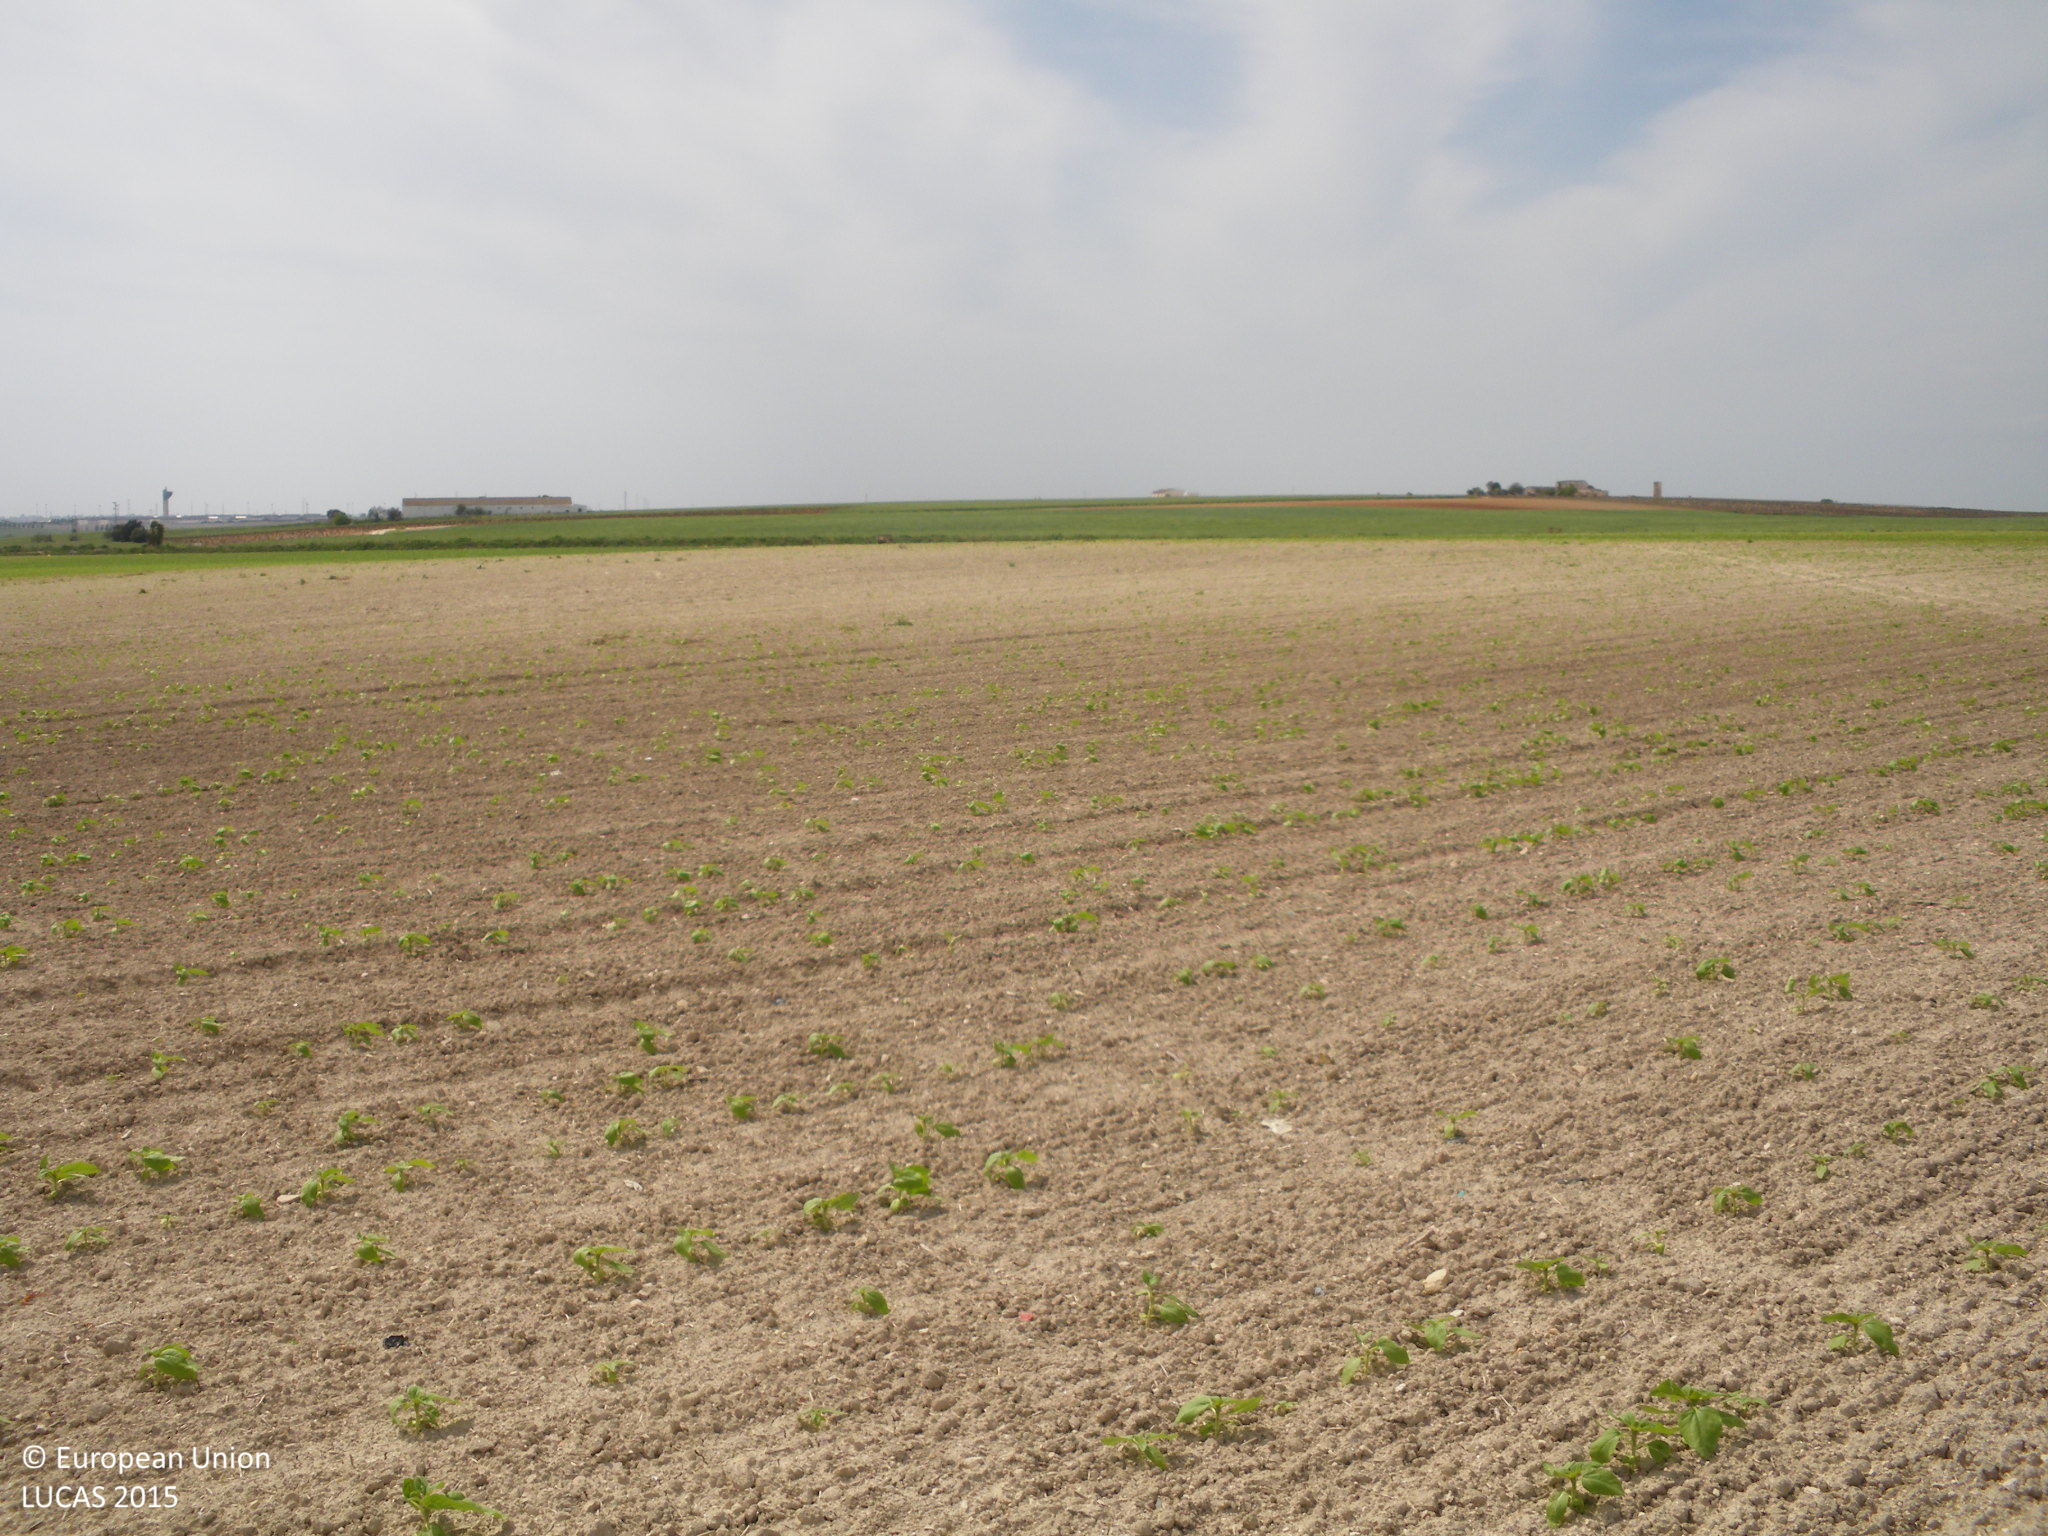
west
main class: Cropland
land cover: Sunflower
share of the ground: < 10 %
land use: Agriculture (excluding fallow land and kitchen gardens)
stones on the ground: < 10 %
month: April
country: ES
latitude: 36.6758
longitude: -6.2274
